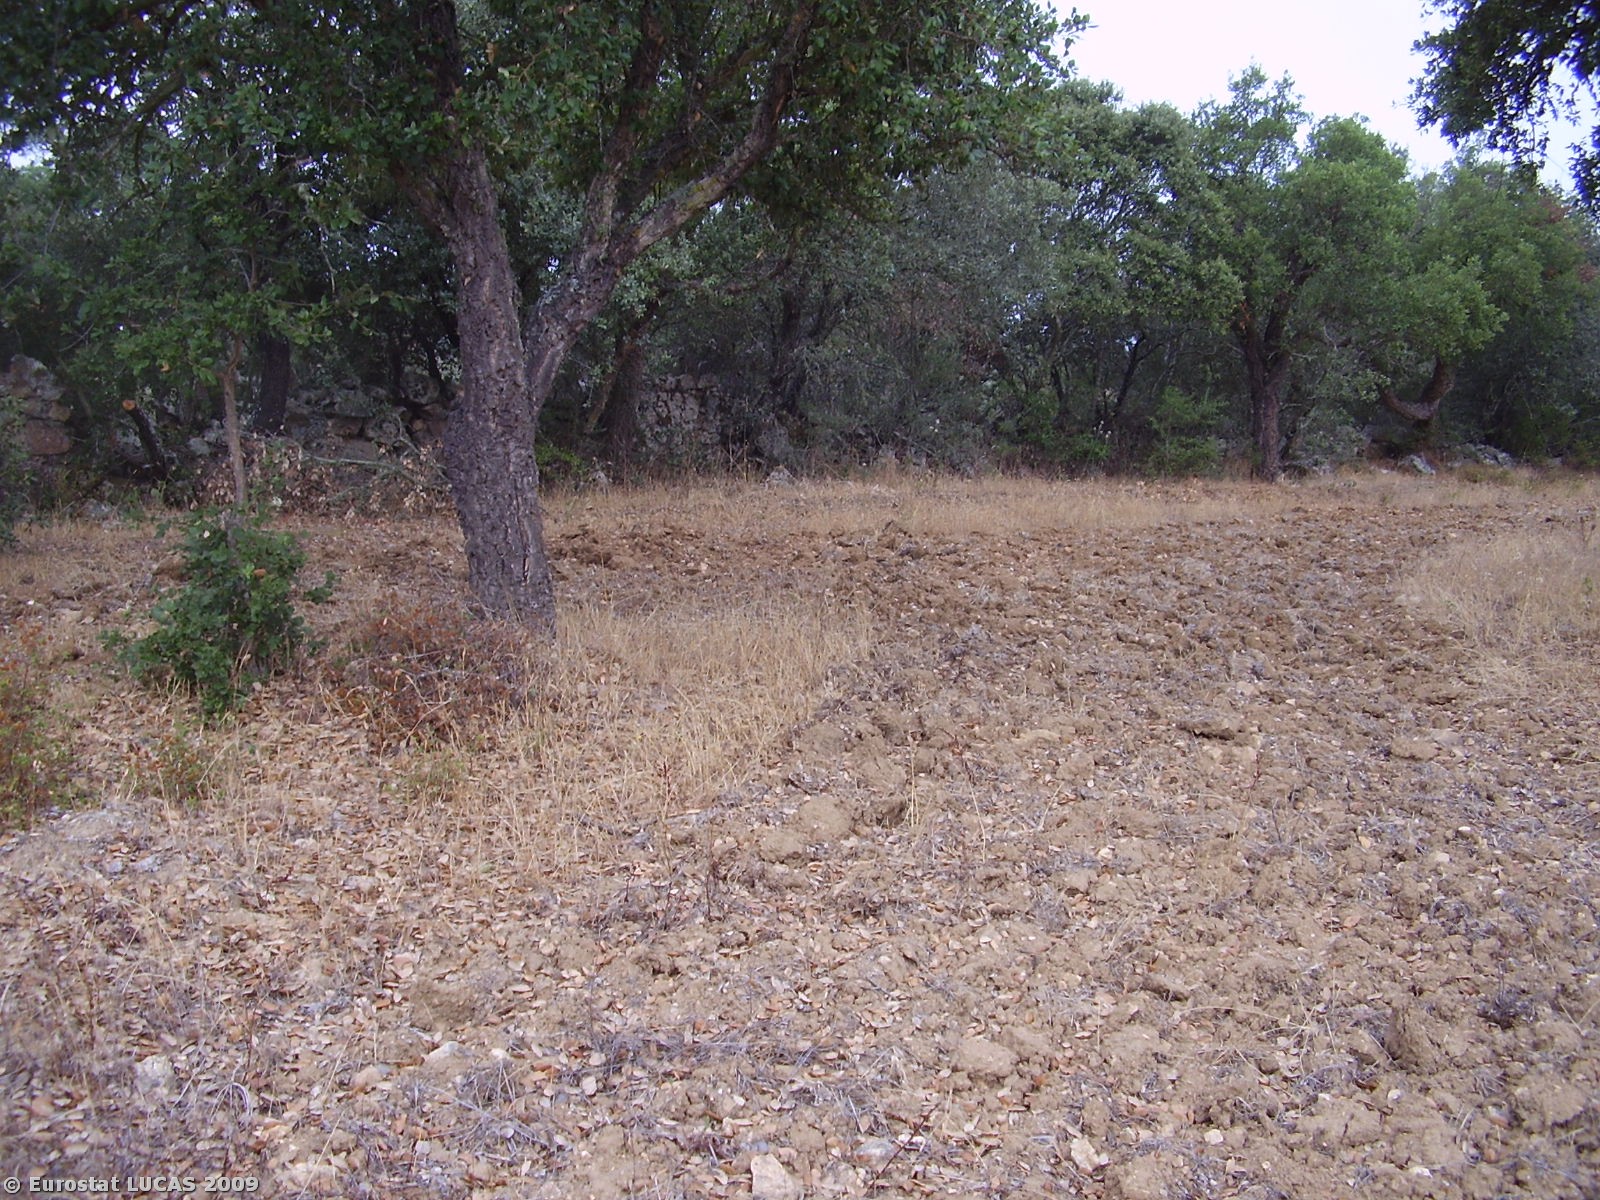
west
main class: Cropland
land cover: Olive groves
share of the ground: 10 - 25 %
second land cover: Spontaneously vegetated surfaces
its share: 50 - 75 %
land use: Agriculture (excluding fallow land and kitchen gardens)
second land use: Fallow land
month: July
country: PT
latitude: 38.8168
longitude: -7.8598
